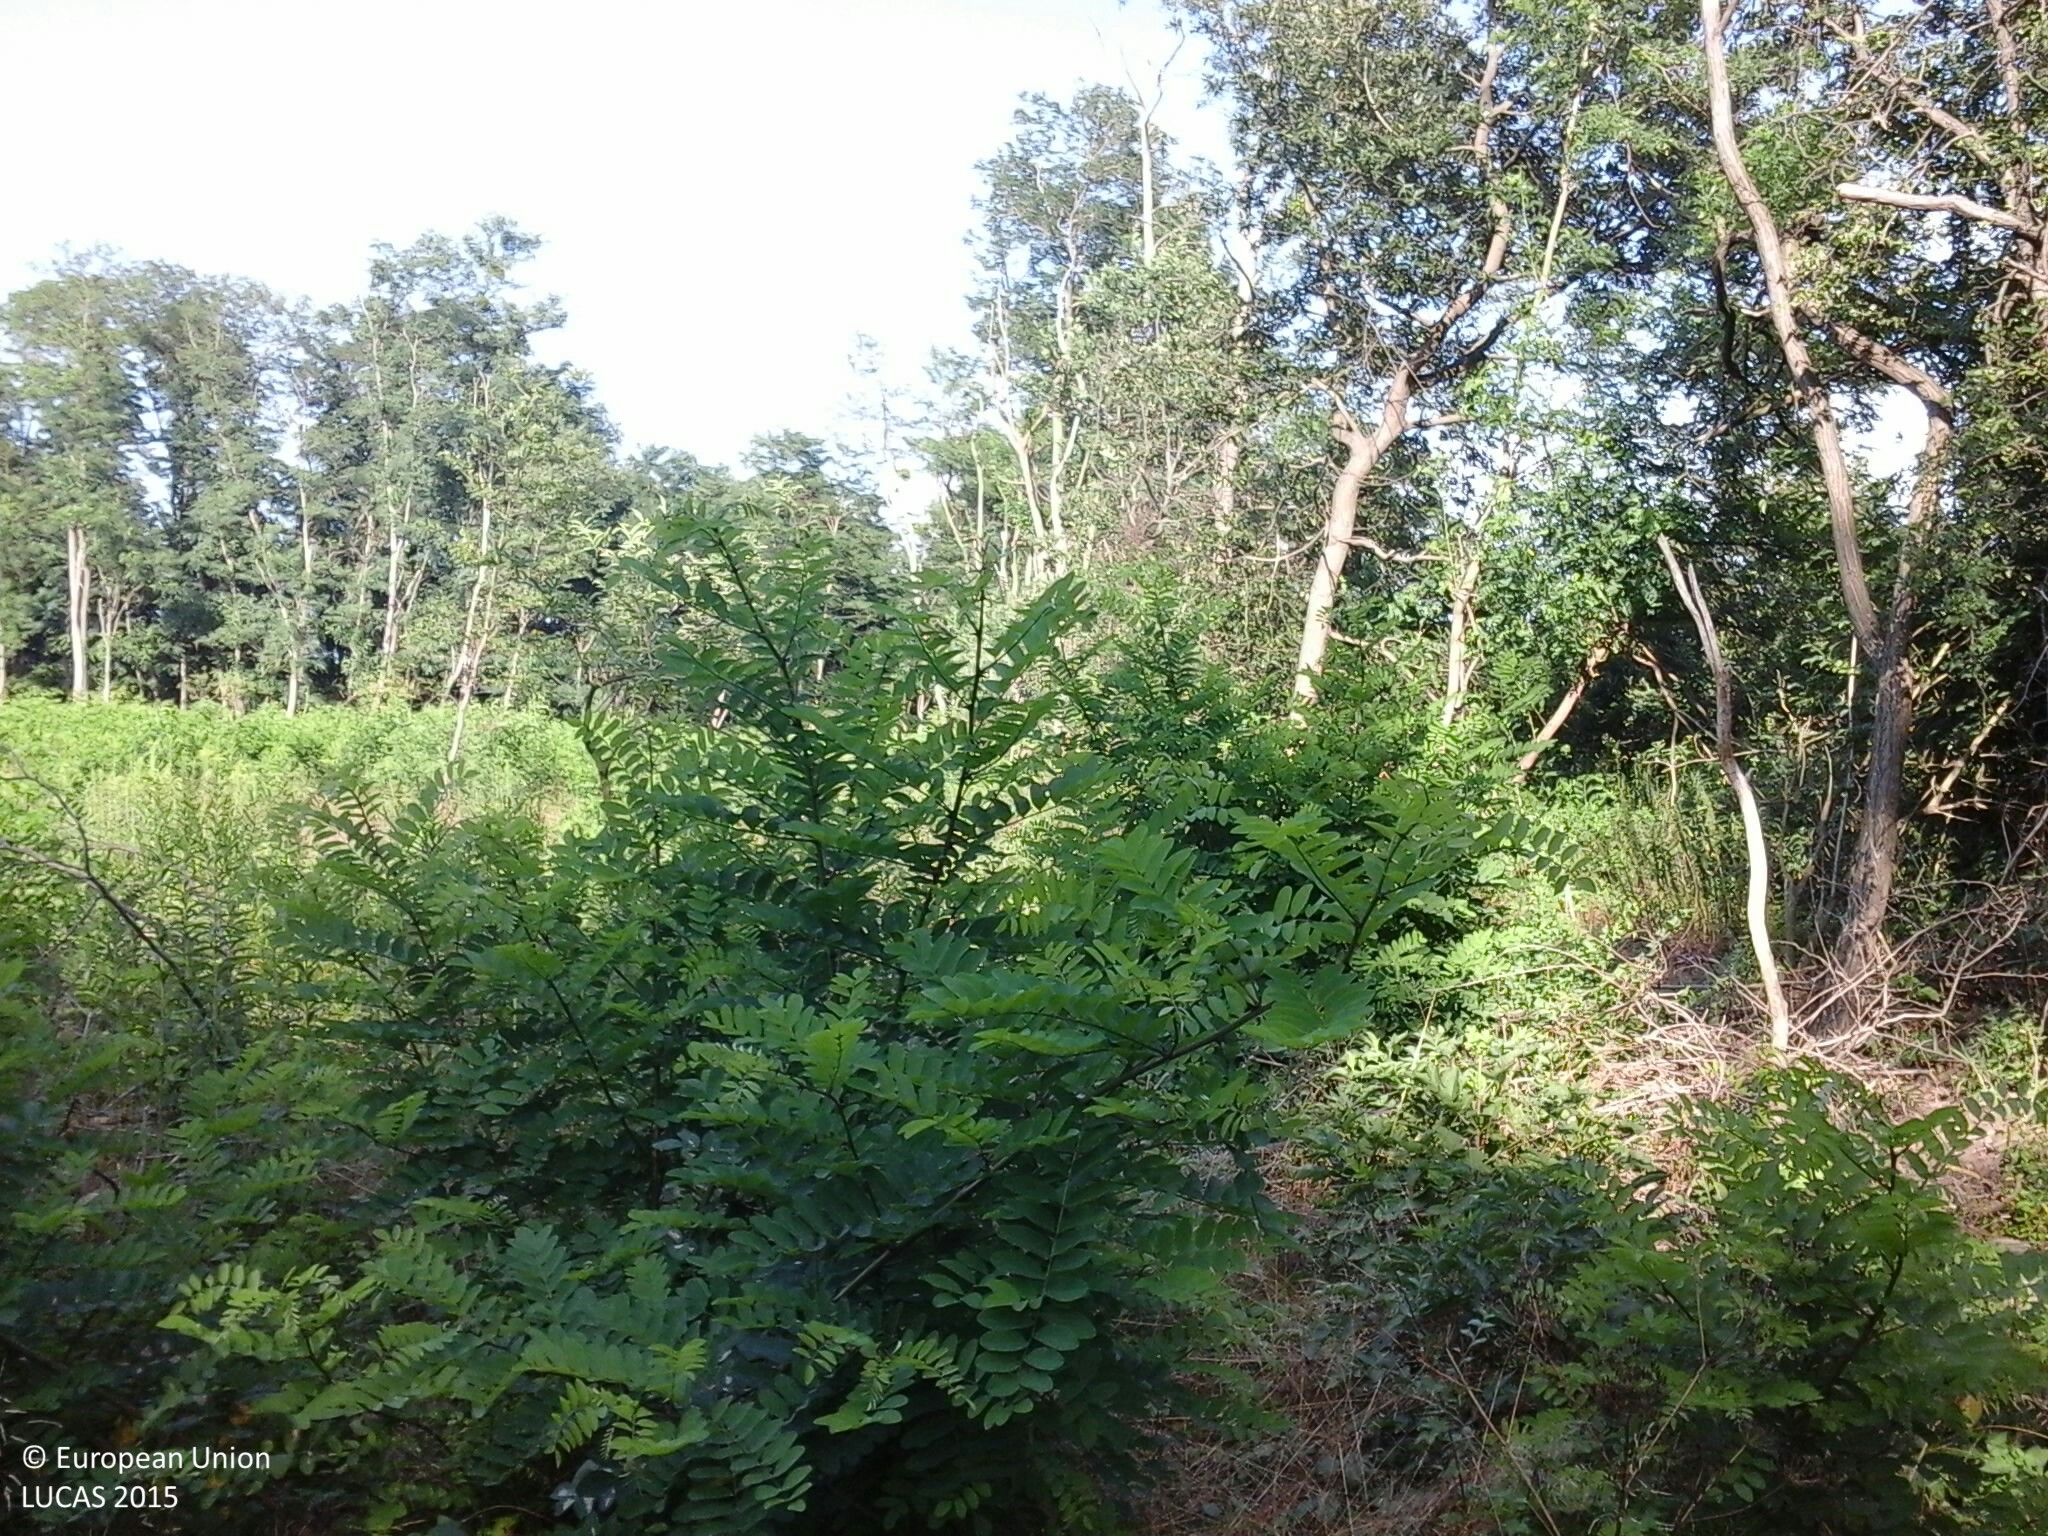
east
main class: Woodland
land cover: Broadleaved woodland
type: exotic forest
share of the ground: > 75 %
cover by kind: broadleaved forest trees 75 %, herbaceous plants 15 %, shrubs 10 %
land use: Forestry
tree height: > 5 m
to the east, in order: Broadleaved woodland; Tracks; Grassland without tree/shrub cover; Tracks; Grassland without tree/shrub cover
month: July
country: HU
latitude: 46.9747
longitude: 17.2218
